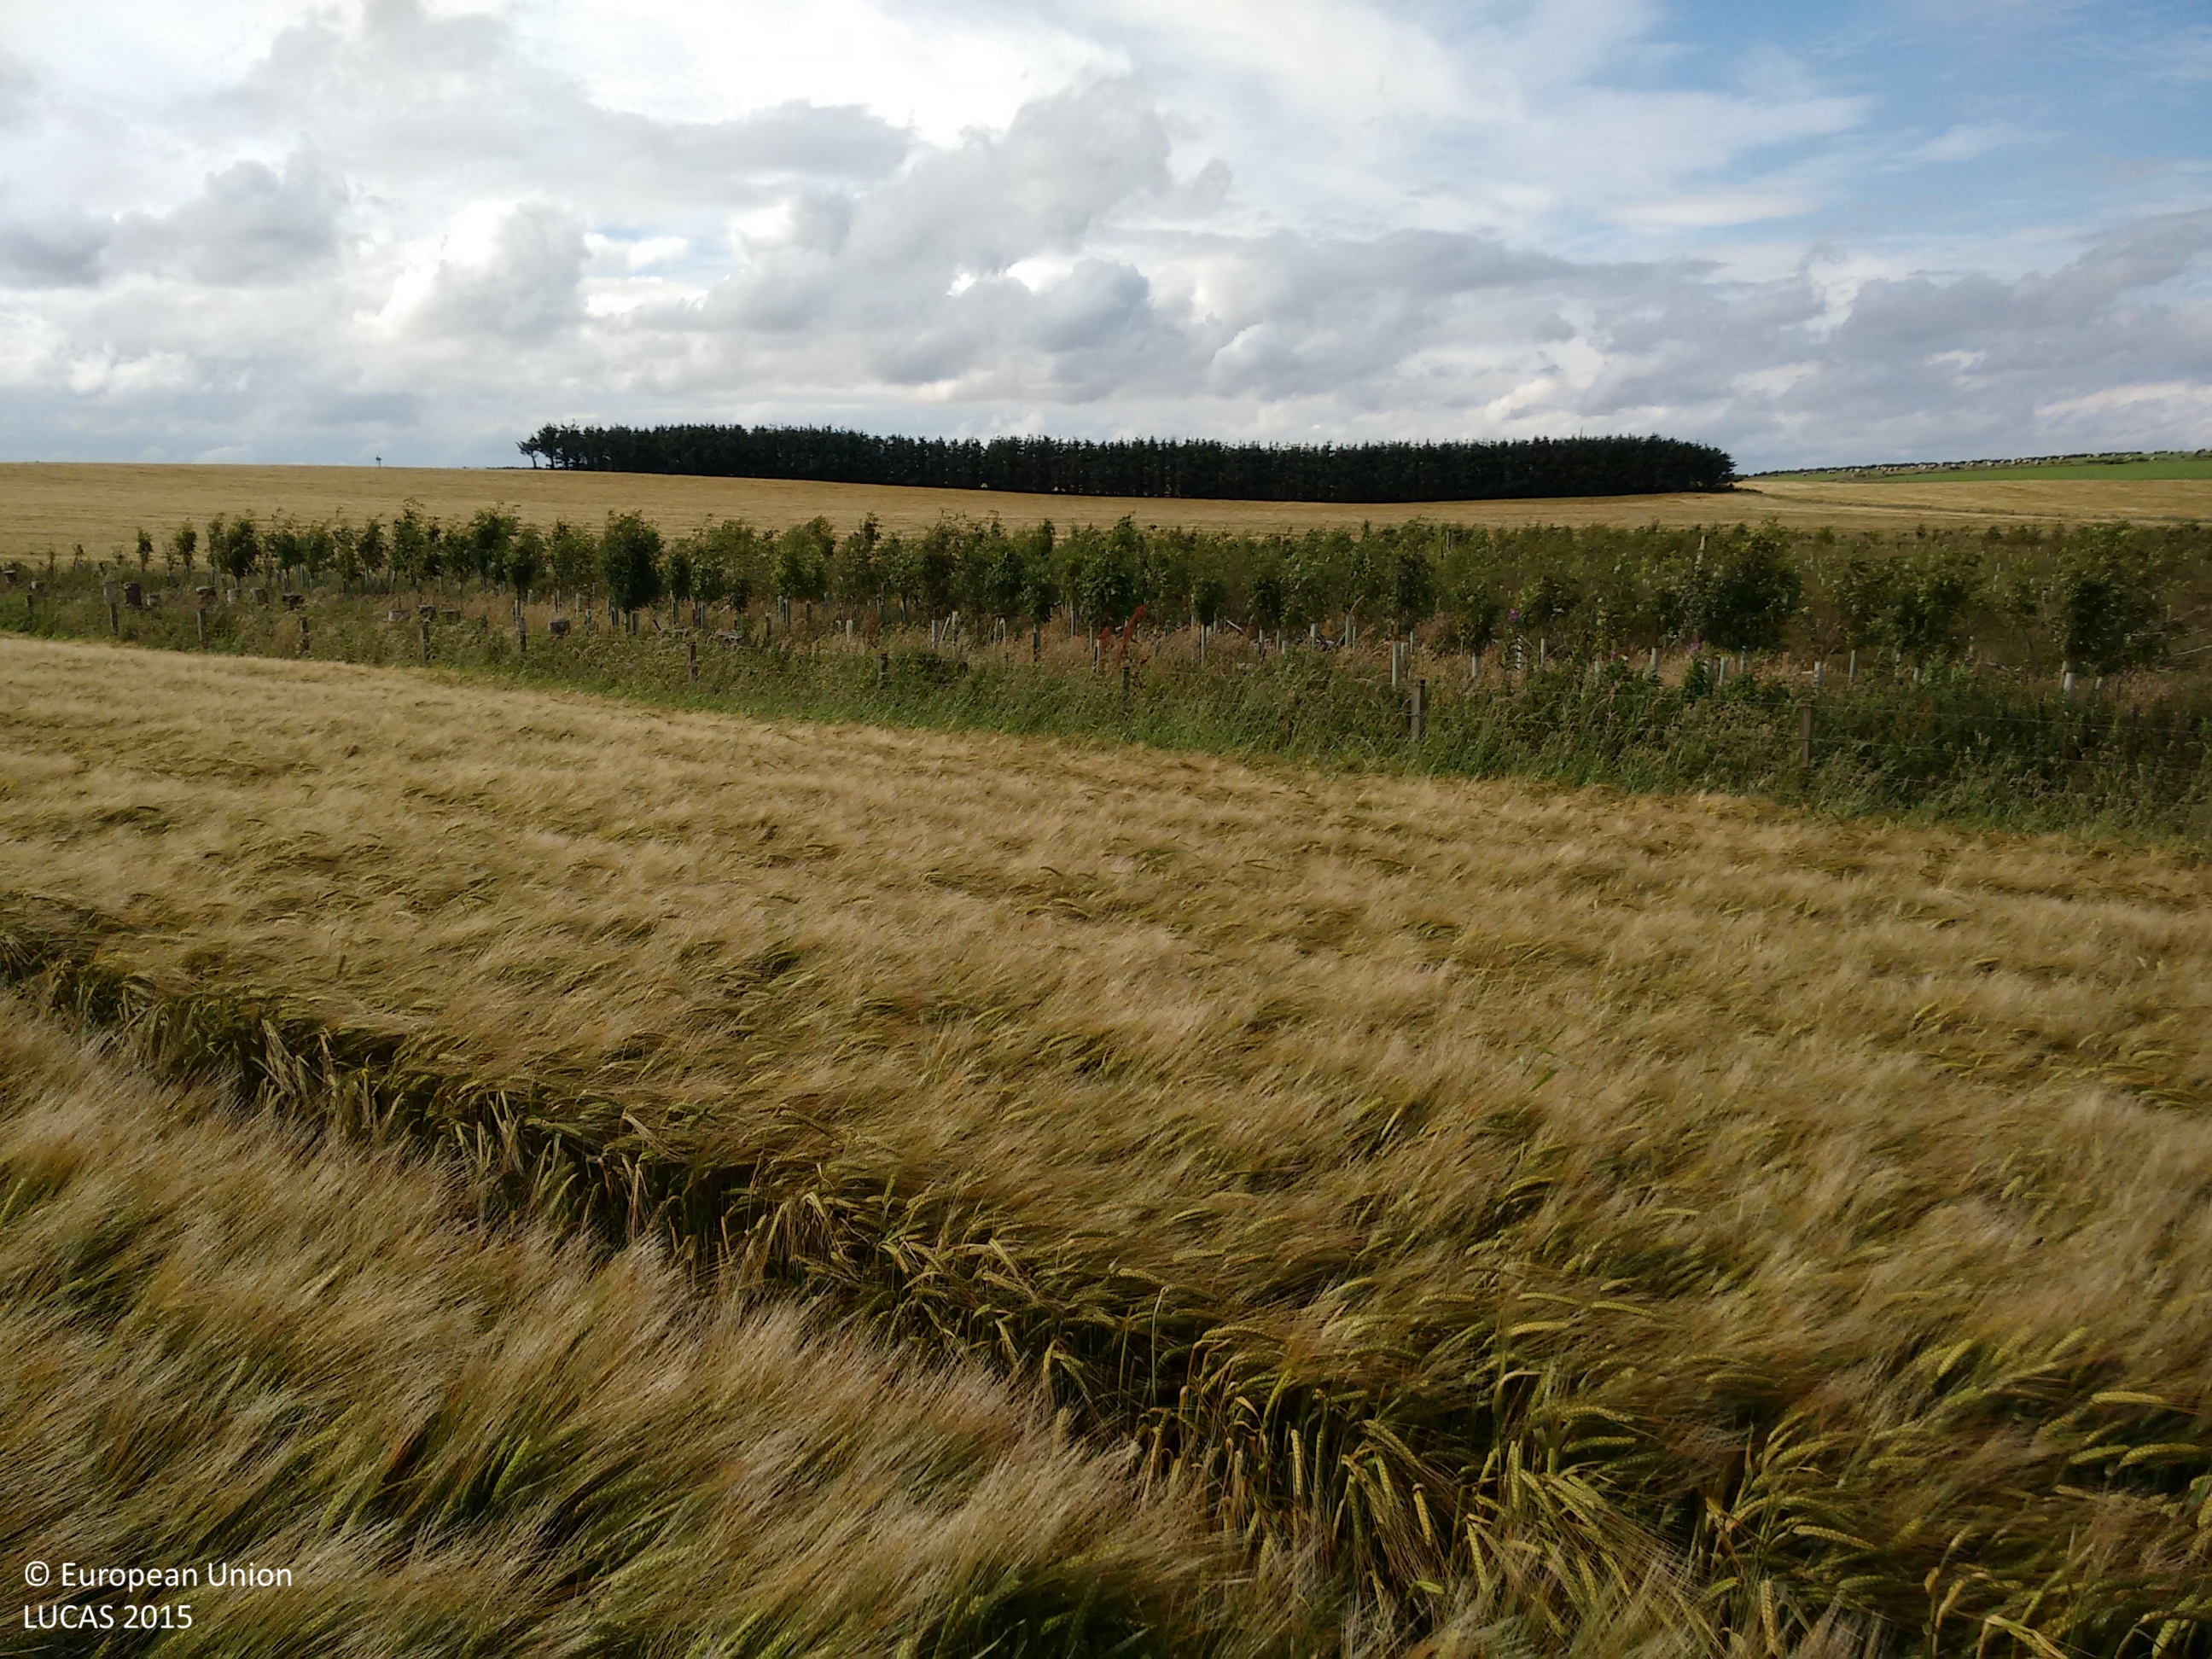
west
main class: Cropland
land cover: Barley
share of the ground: > 75 %
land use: Agriculture (excluding fallow land and kitchen gardens)
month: August
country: GB
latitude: 57.5698
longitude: -2.2026
